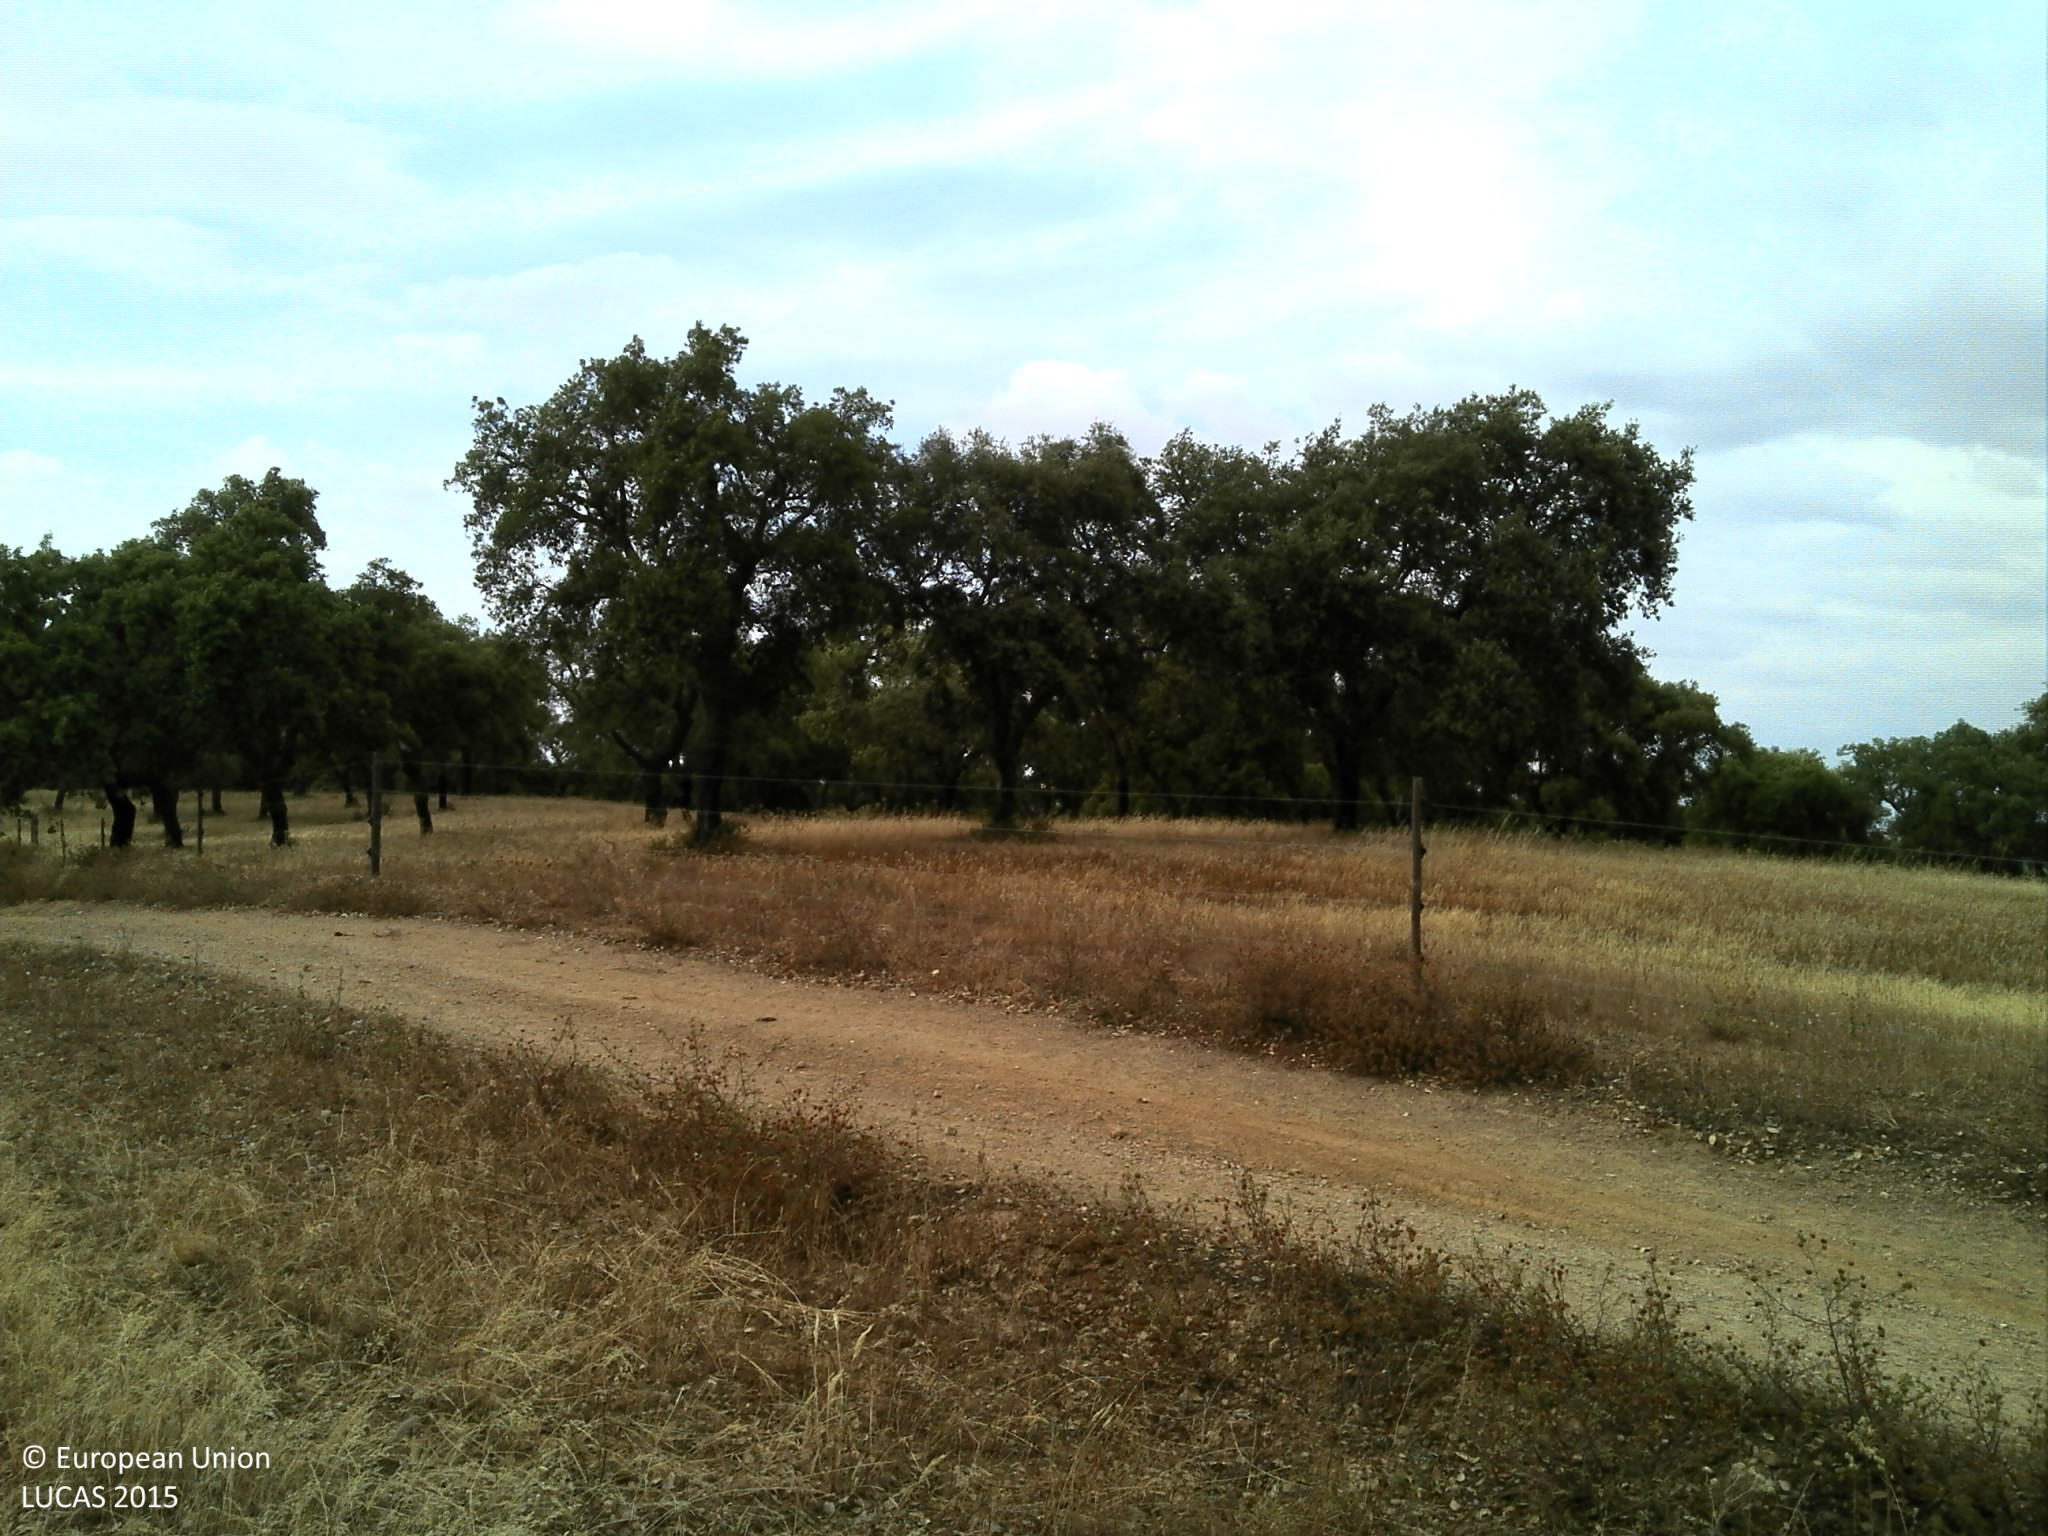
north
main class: Woodland
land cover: Broadleaved woodland
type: broadleaved evergreen forest
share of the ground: 25 - 50 %
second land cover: Spontaneously vegetated surfaces
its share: 50 - 75 %
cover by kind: herbaceous plants 60 %, broadleaved forest trees 25 %, unconsolidated bare surface 15 %
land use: Forestry
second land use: Agriculture (excluding fallow land and kitchen gardens)
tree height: > 5 m
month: June
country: PT
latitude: 38.3998
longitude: -7.8167
